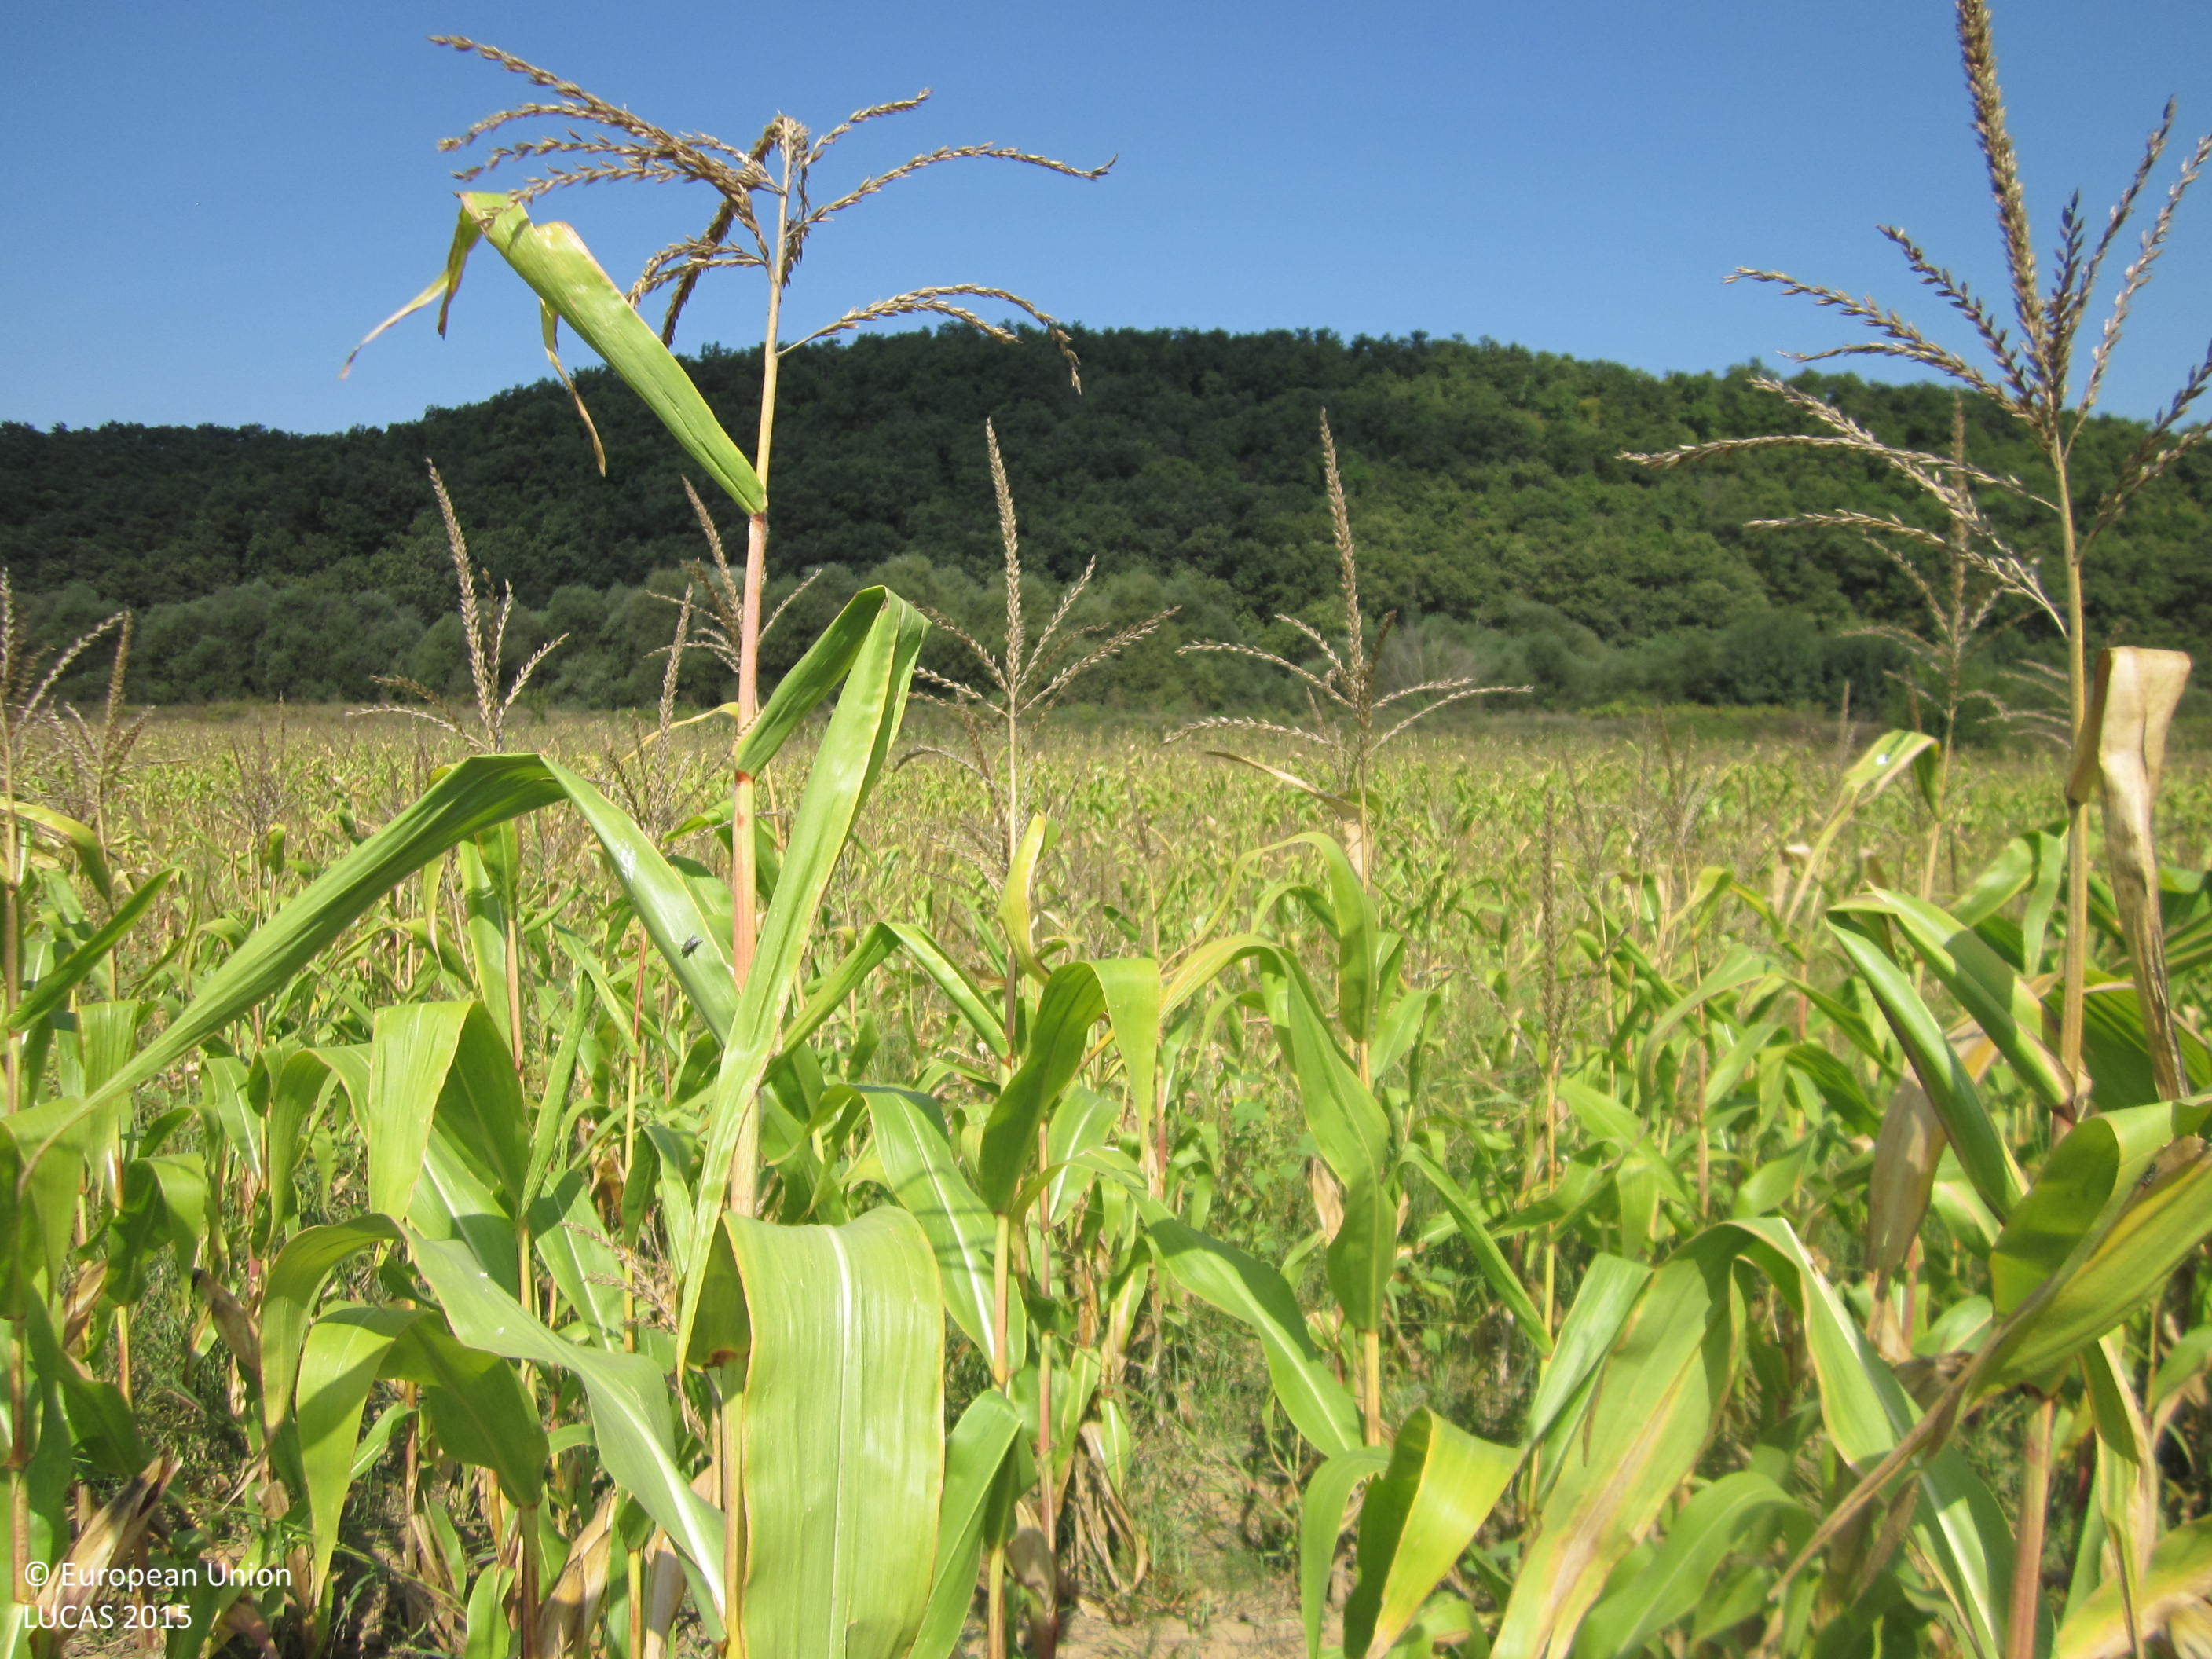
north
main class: Cropland
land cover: Maize
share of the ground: > 75 %
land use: Agriculture (excluding fallow land and kitchen gardens)
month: September
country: BG
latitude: 42.3219
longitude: 27.3540
